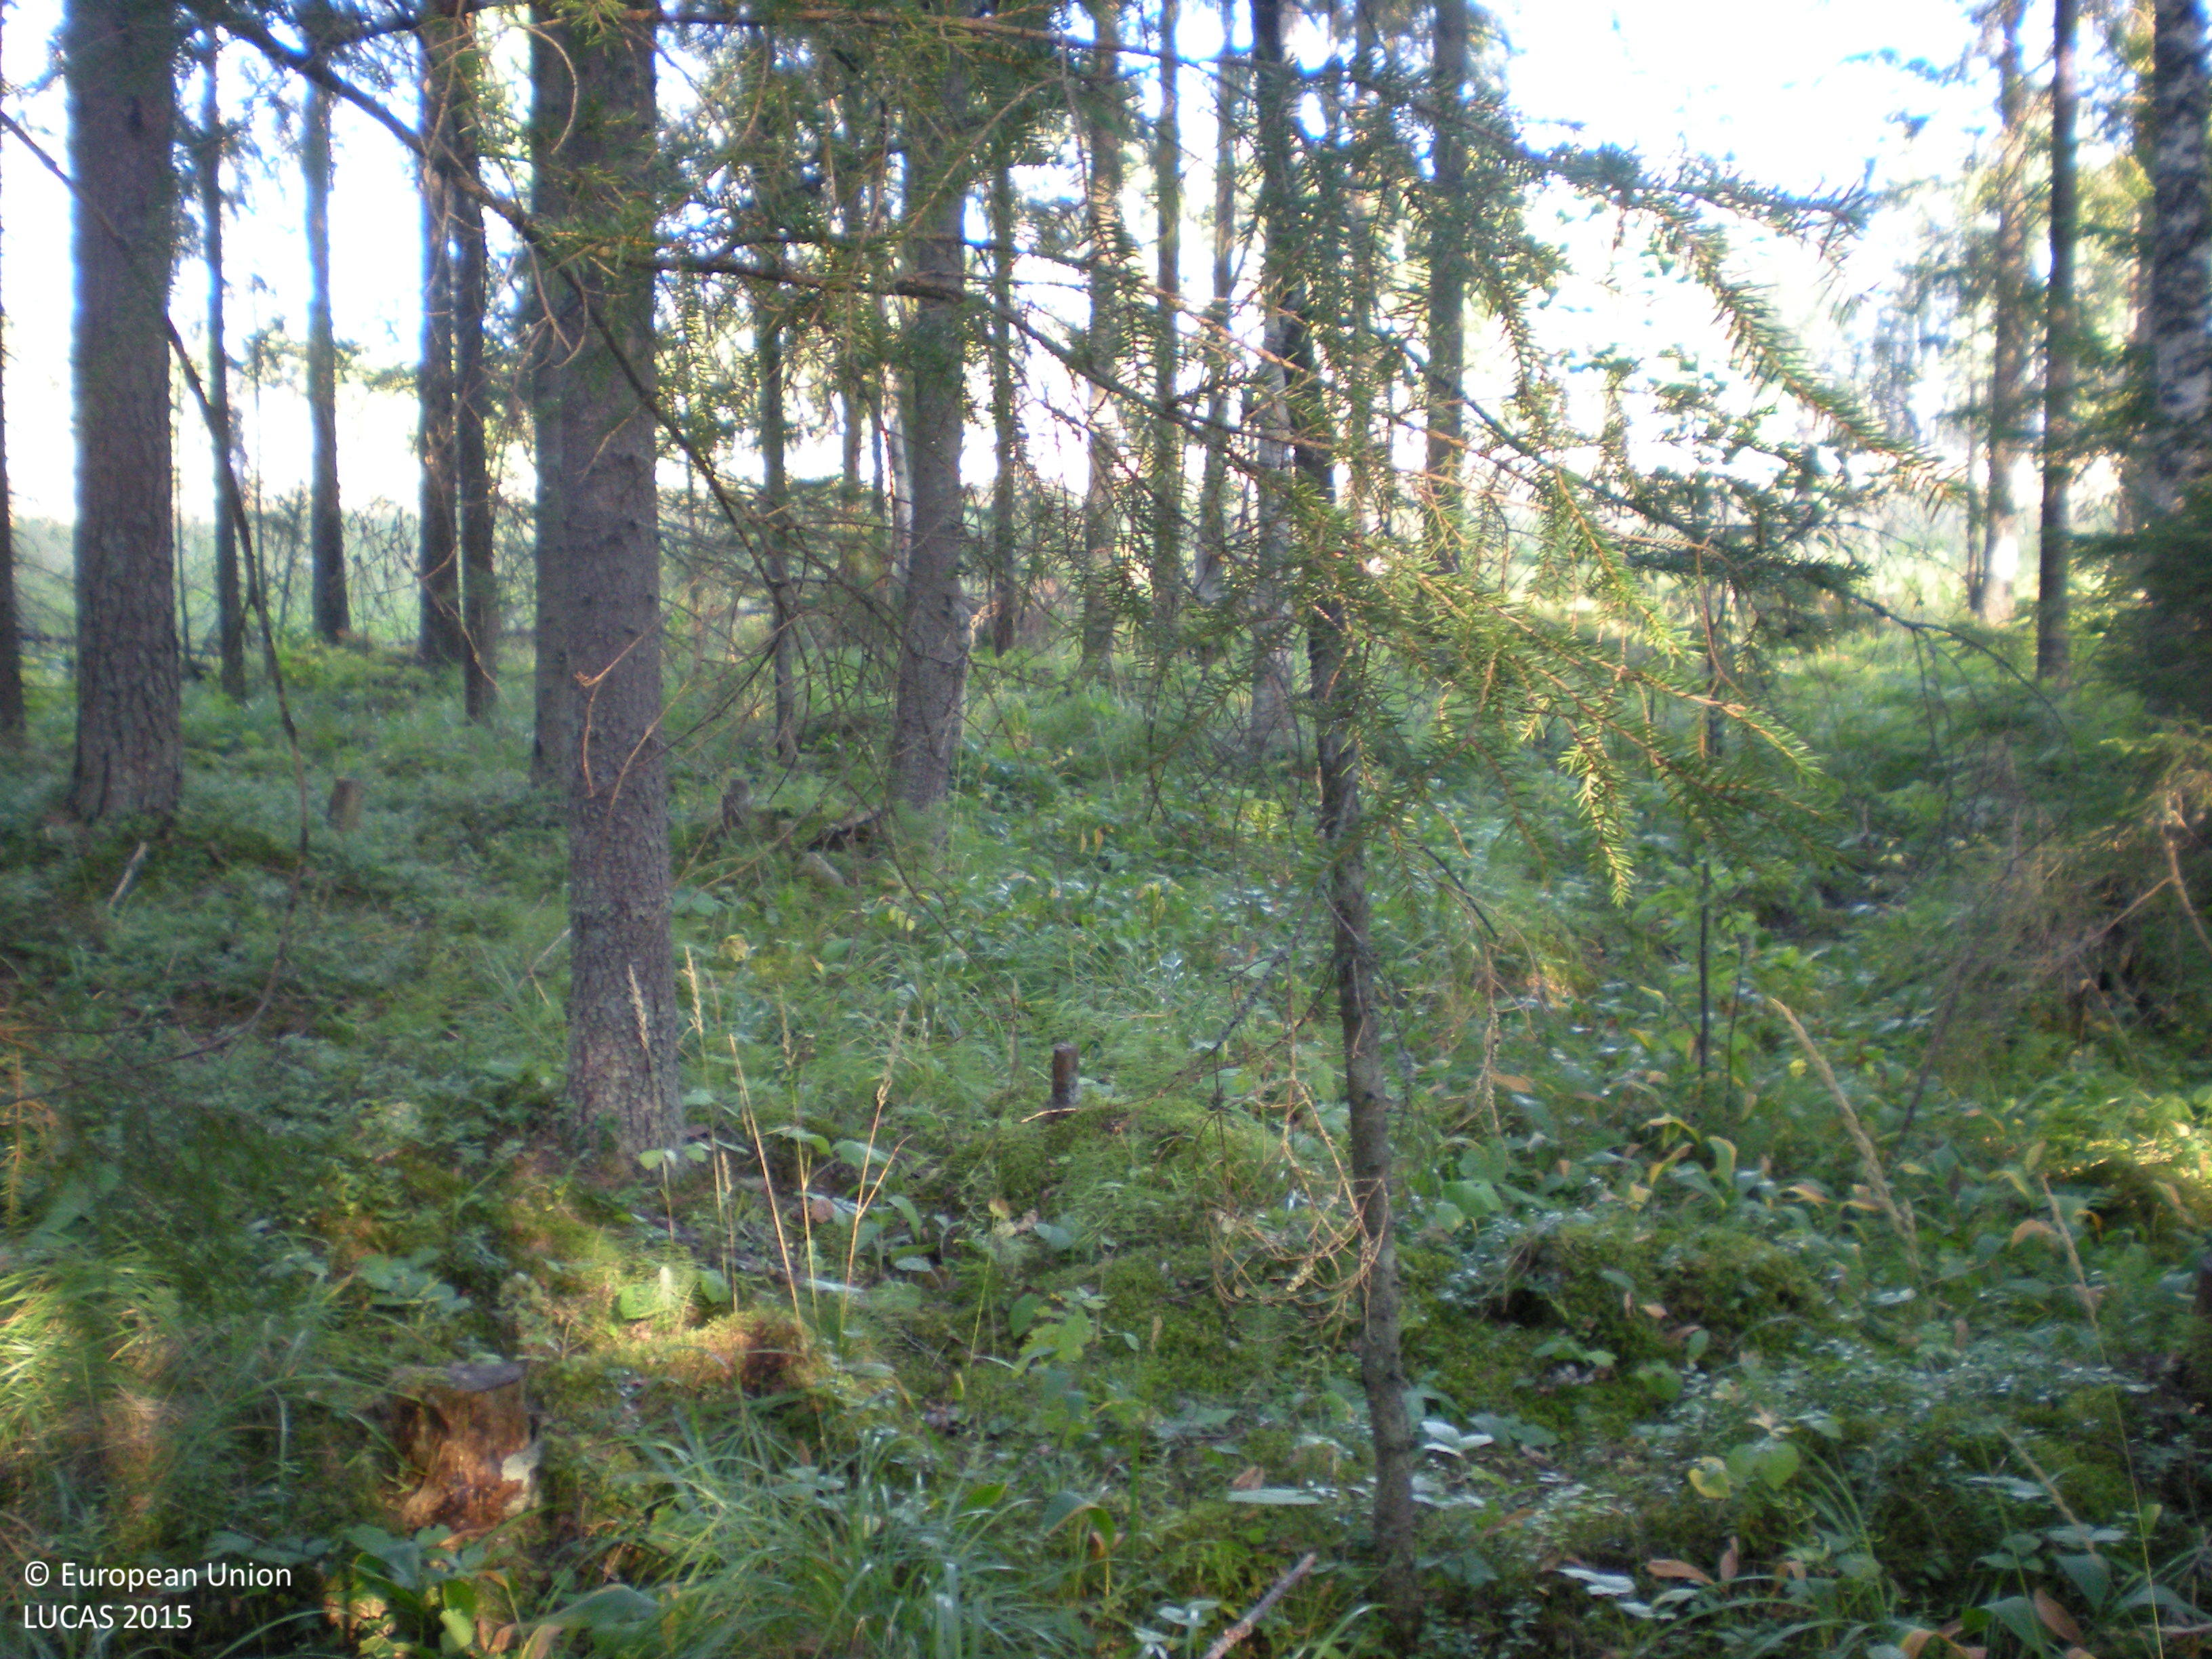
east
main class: Woodland
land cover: Spruce dominated coniferous woodland
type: boreal forest
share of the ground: 50 - 75 %
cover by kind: coniferous forest trees 70 %, herbaceous plants 10 %, lichens and mosses 10 %, broadleaved forest trees 5 %, shrubs 5 %
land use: Forestry
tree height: > 5 m
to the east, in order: Spruce dominated coniferous woodland; Broadleaved woodland; Pine dominated mixed woodland; Broadleaved woodland
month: August
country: SE
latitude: 60.5701
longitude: 17.3062
